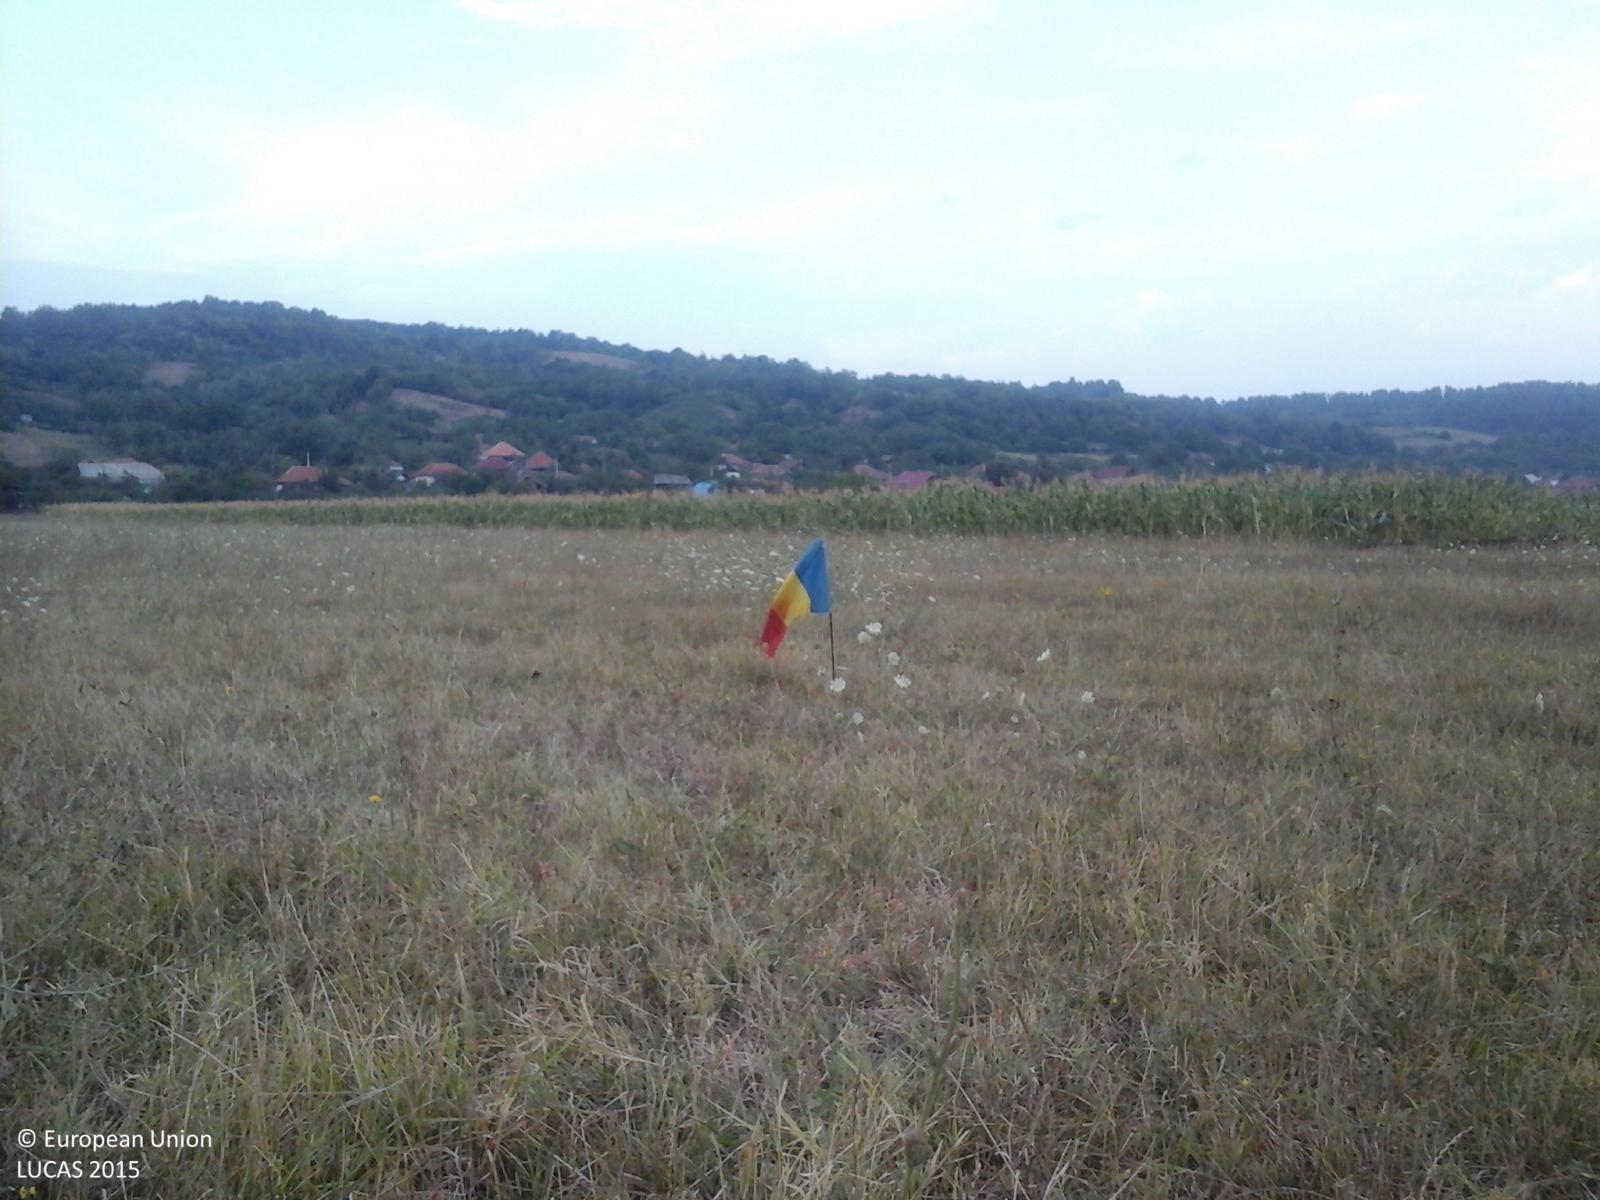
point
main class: Grassland
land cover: Grassland without tree/shrub cover
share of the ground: > 75 %
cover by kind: herbaceous plants 100 %
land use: Agriculture (excluding fallow land and kitchen gardens)
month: August
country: RO
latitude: 44.6927
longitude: 23.0320
